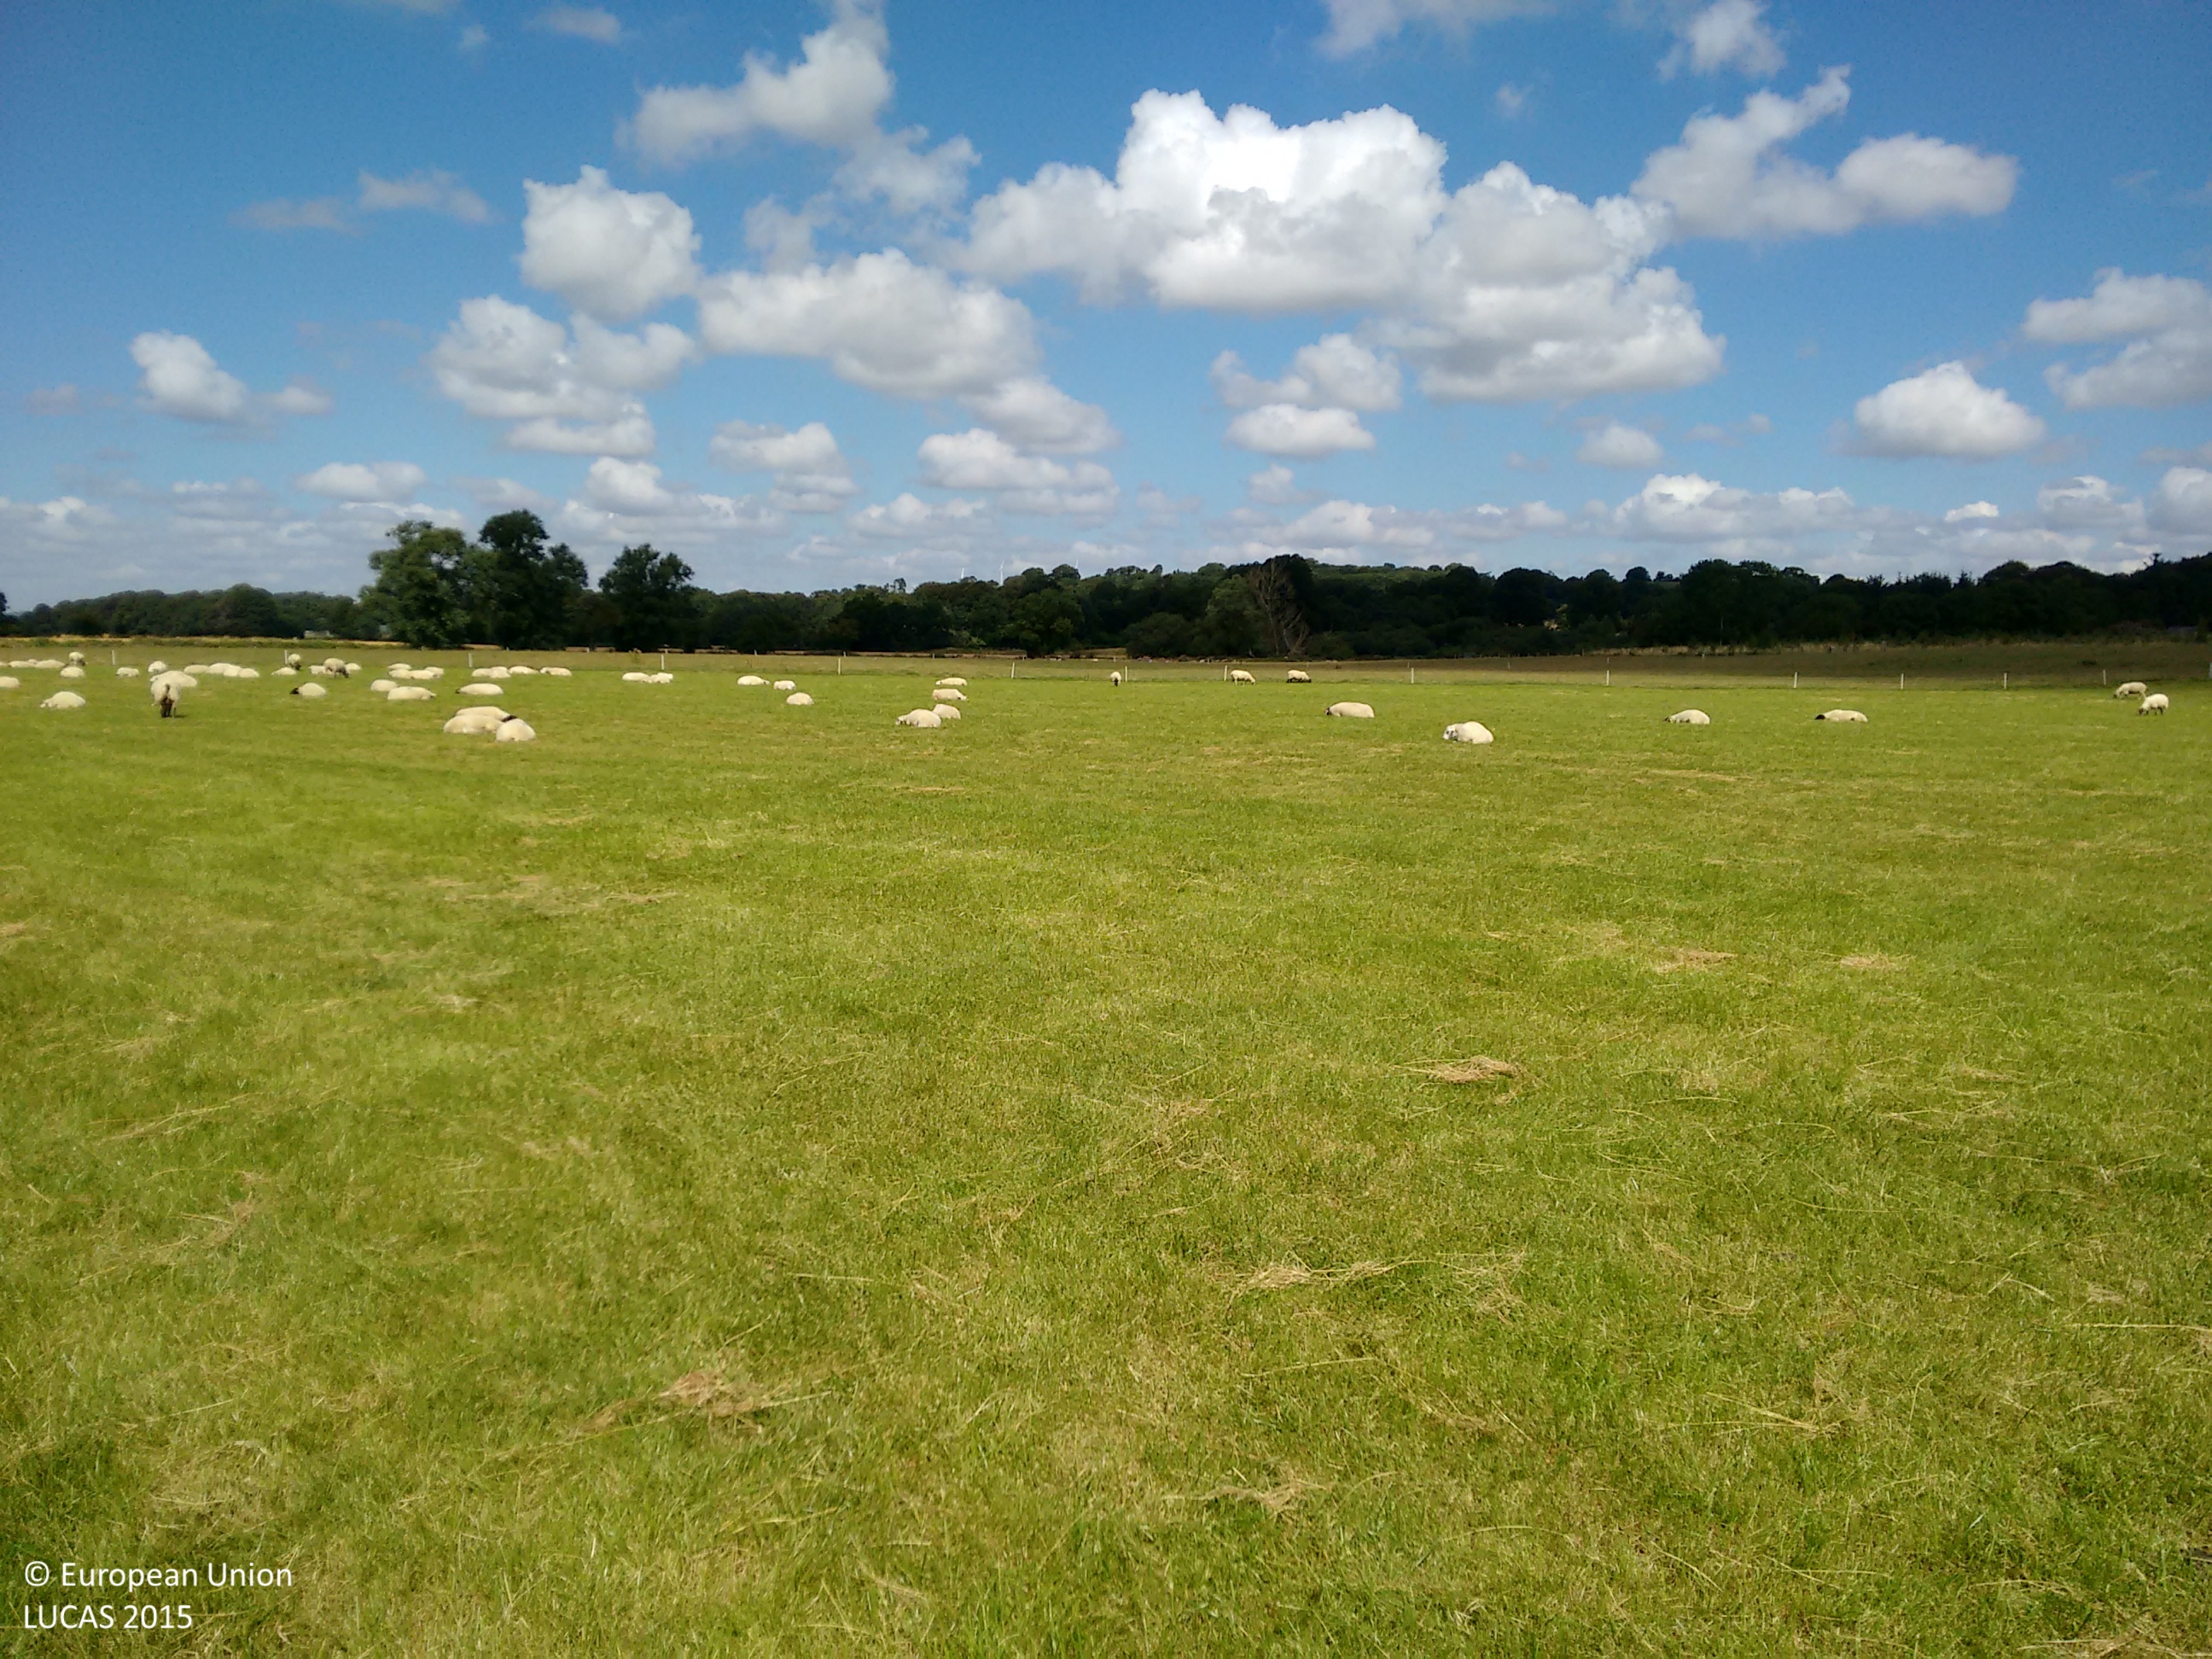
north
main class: Grassland
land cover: Grassland without tree/shrub cover
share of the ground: > 75 %
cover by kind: herbaceous plants 100 %
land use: Agriculture (excluding fallow land and kitchen gardens)
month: August
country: IE
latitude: 52.6123
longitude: -6.5974
